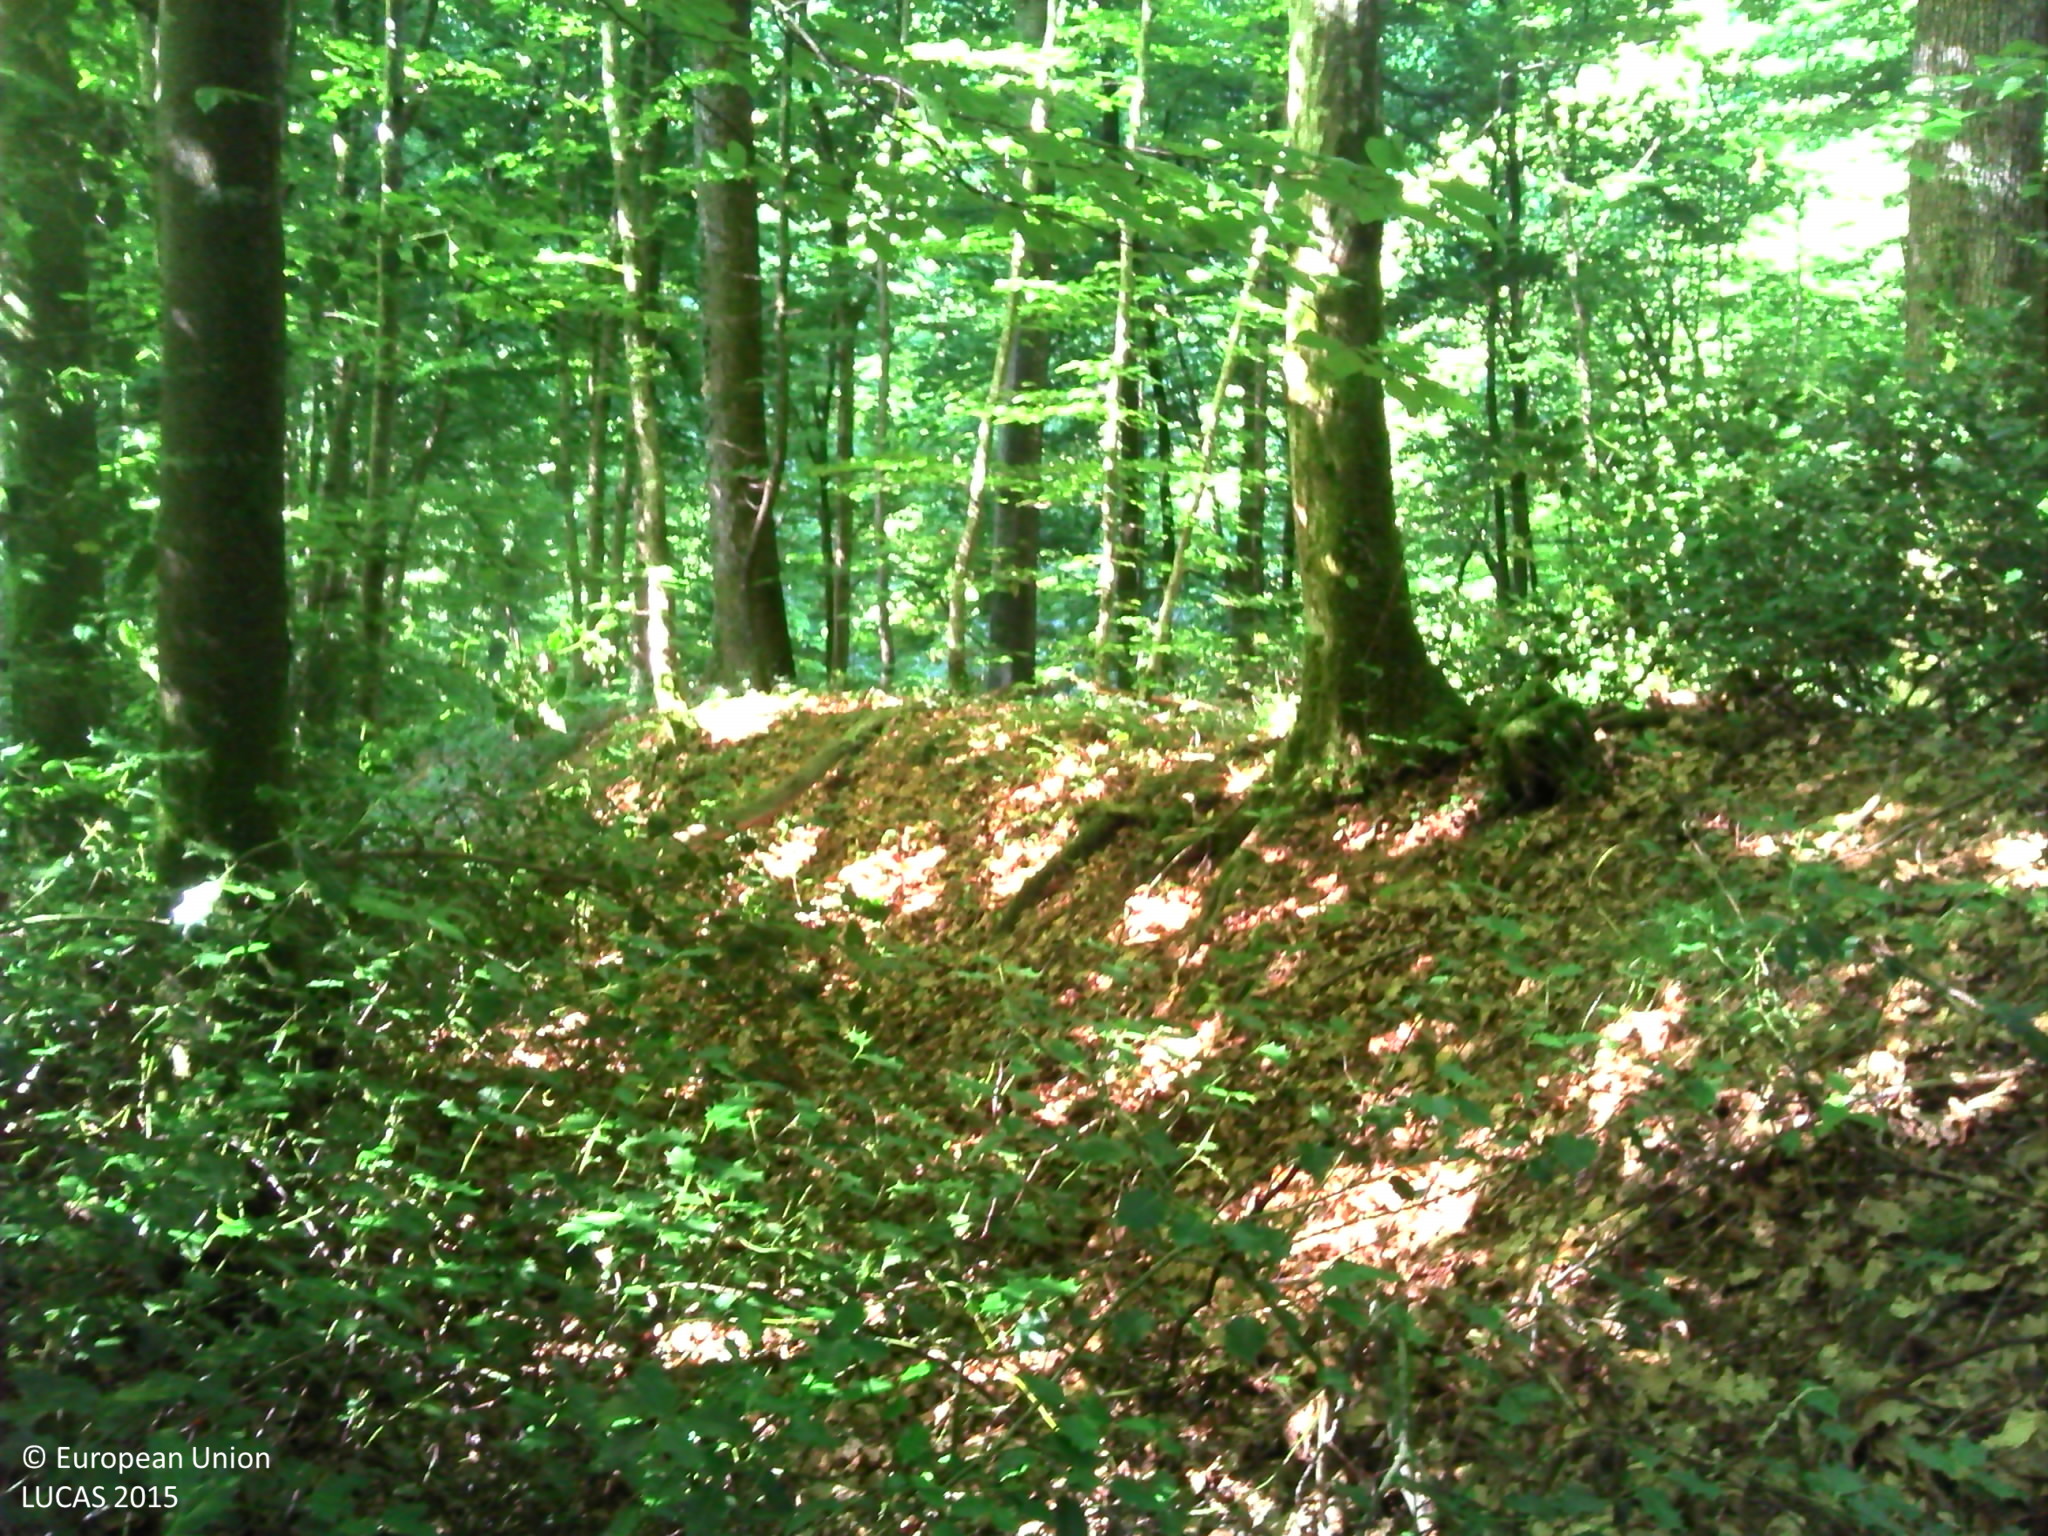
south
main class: Woodland
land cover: Broadleaved woodland
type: beech forest
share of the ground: > 75 %
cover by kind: broadleaved forest trees 95 %, herbaceous plants 5 %
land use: Forestry
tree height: > 5 m
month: June
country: FR
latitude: 47.4174
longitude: 6.1445
